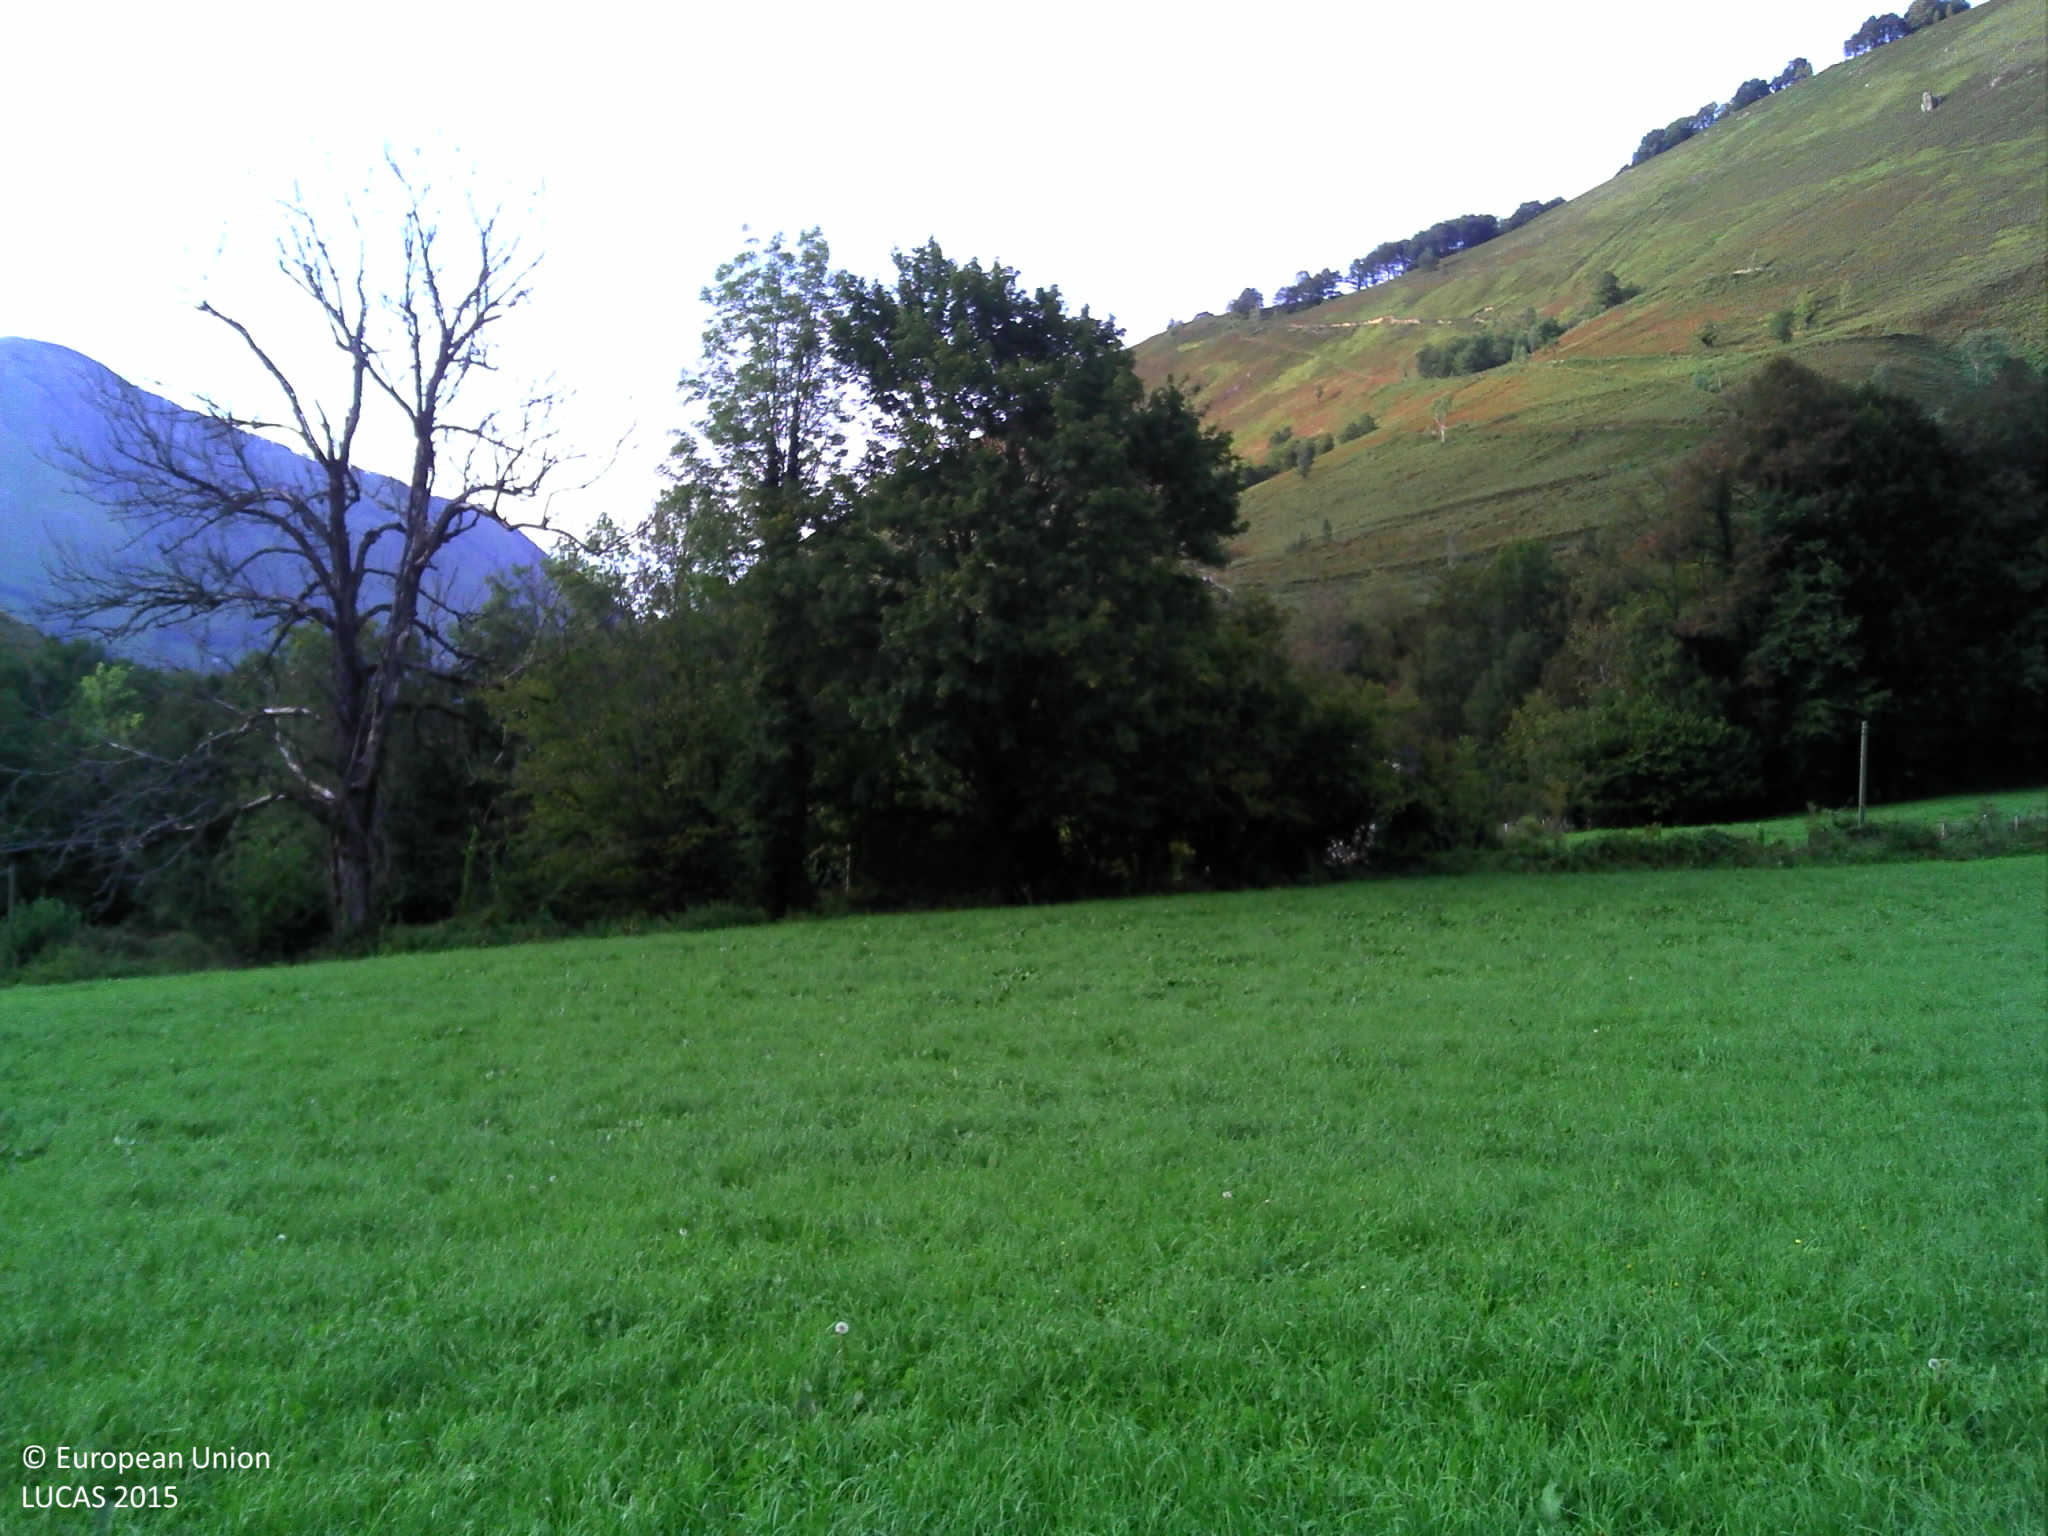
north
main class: Grassland
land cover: Grassland without tree/shrub cover
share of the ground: > 75 %
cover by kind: herbaceous plants 100 %
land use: Agriculture (excluding fallow land and kitchen gardens)
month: September
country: FR
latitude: 42.9709
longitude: -0.5873
